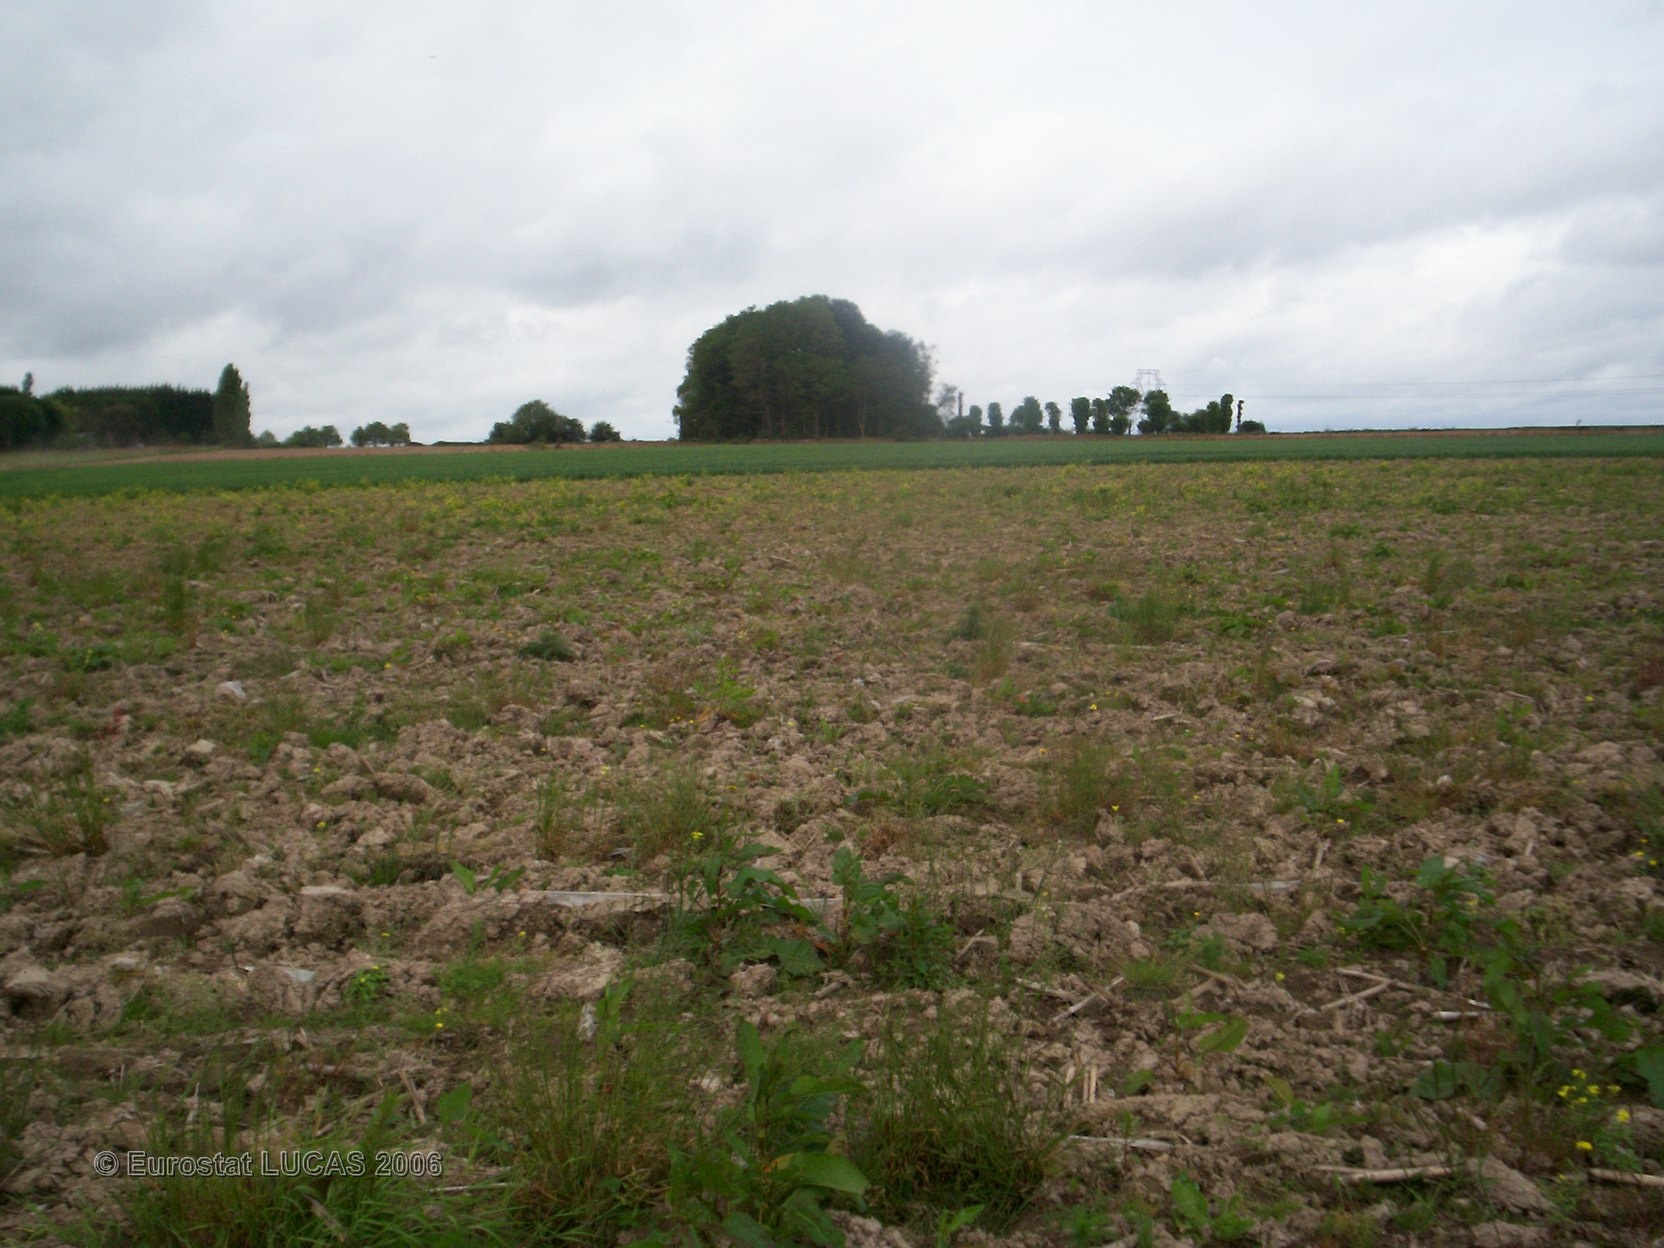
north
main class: Grassland
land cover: Grassland without tree/shrub cover
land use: Fallow land
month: June
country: FR
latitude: 48.2888
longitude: -2.3640
